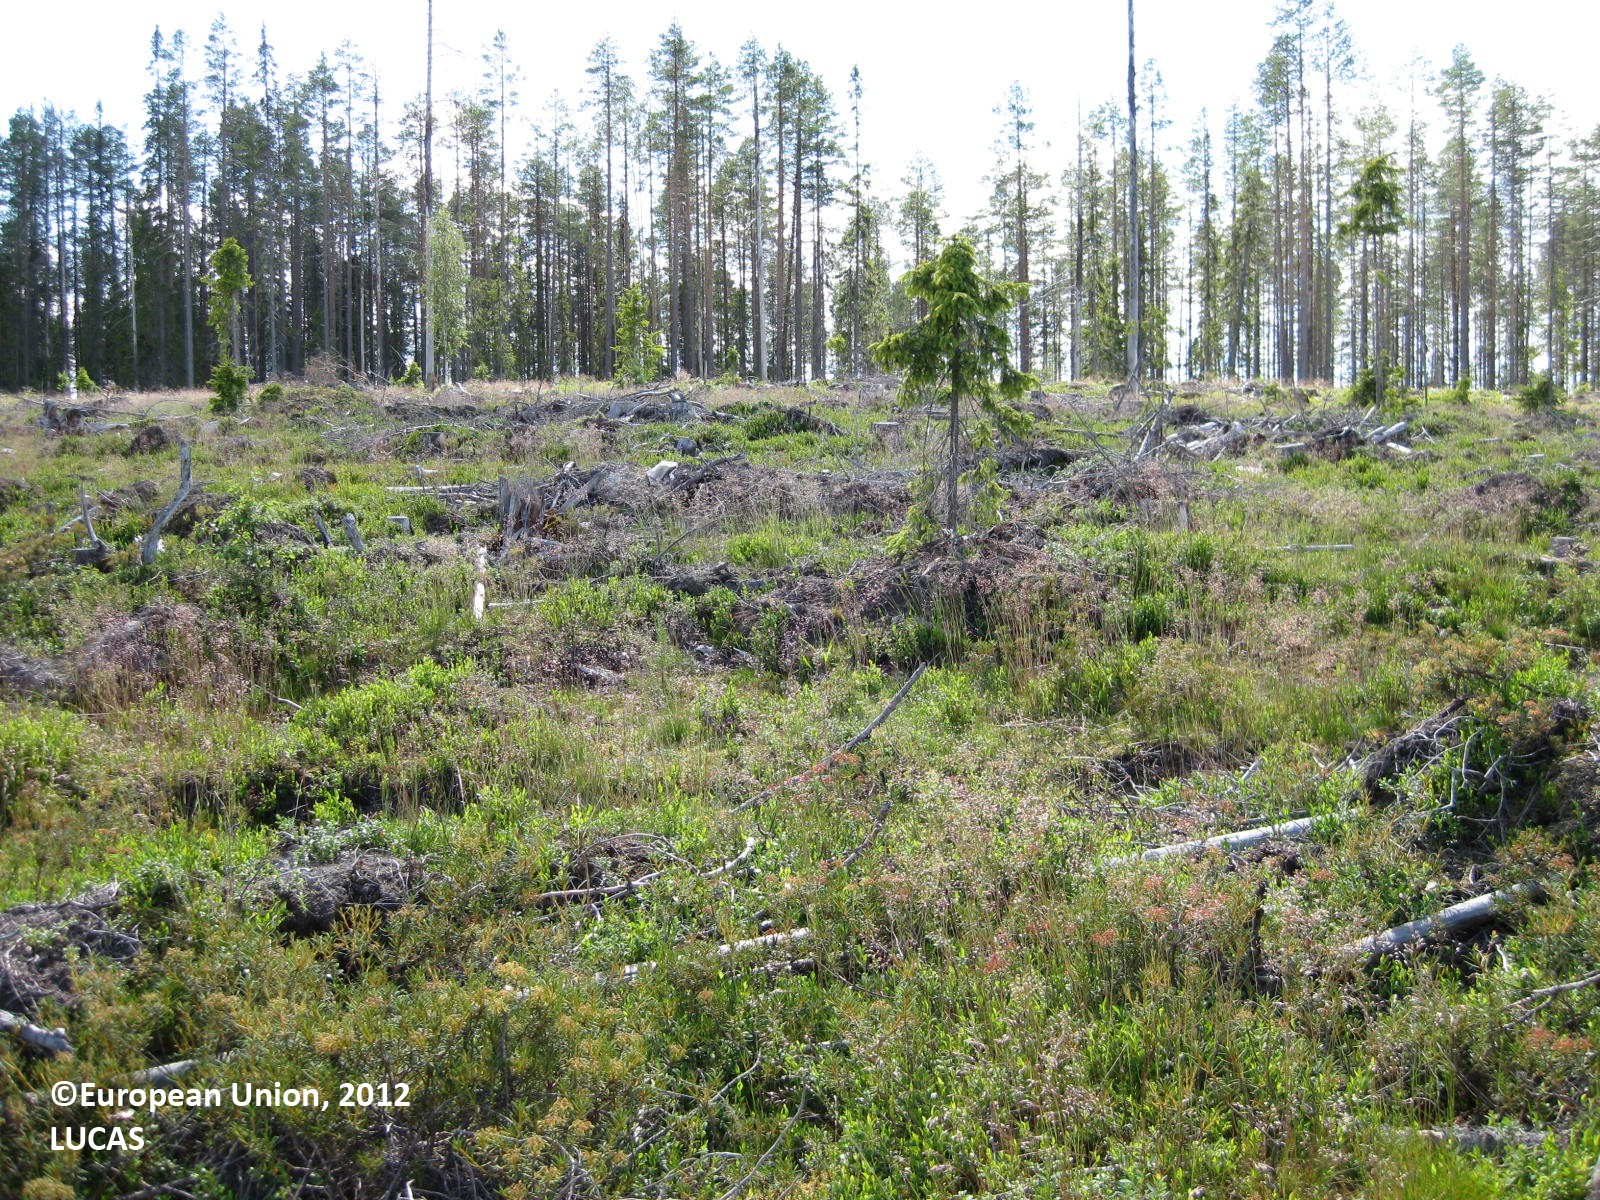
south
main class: Shrubland
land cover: Shrubland with sparse tree cover
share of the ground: > 75 %
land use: Forestry
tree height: < 5 m
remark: Clear cut
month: July
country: FI
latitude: 65.7979
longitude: 29.6329
